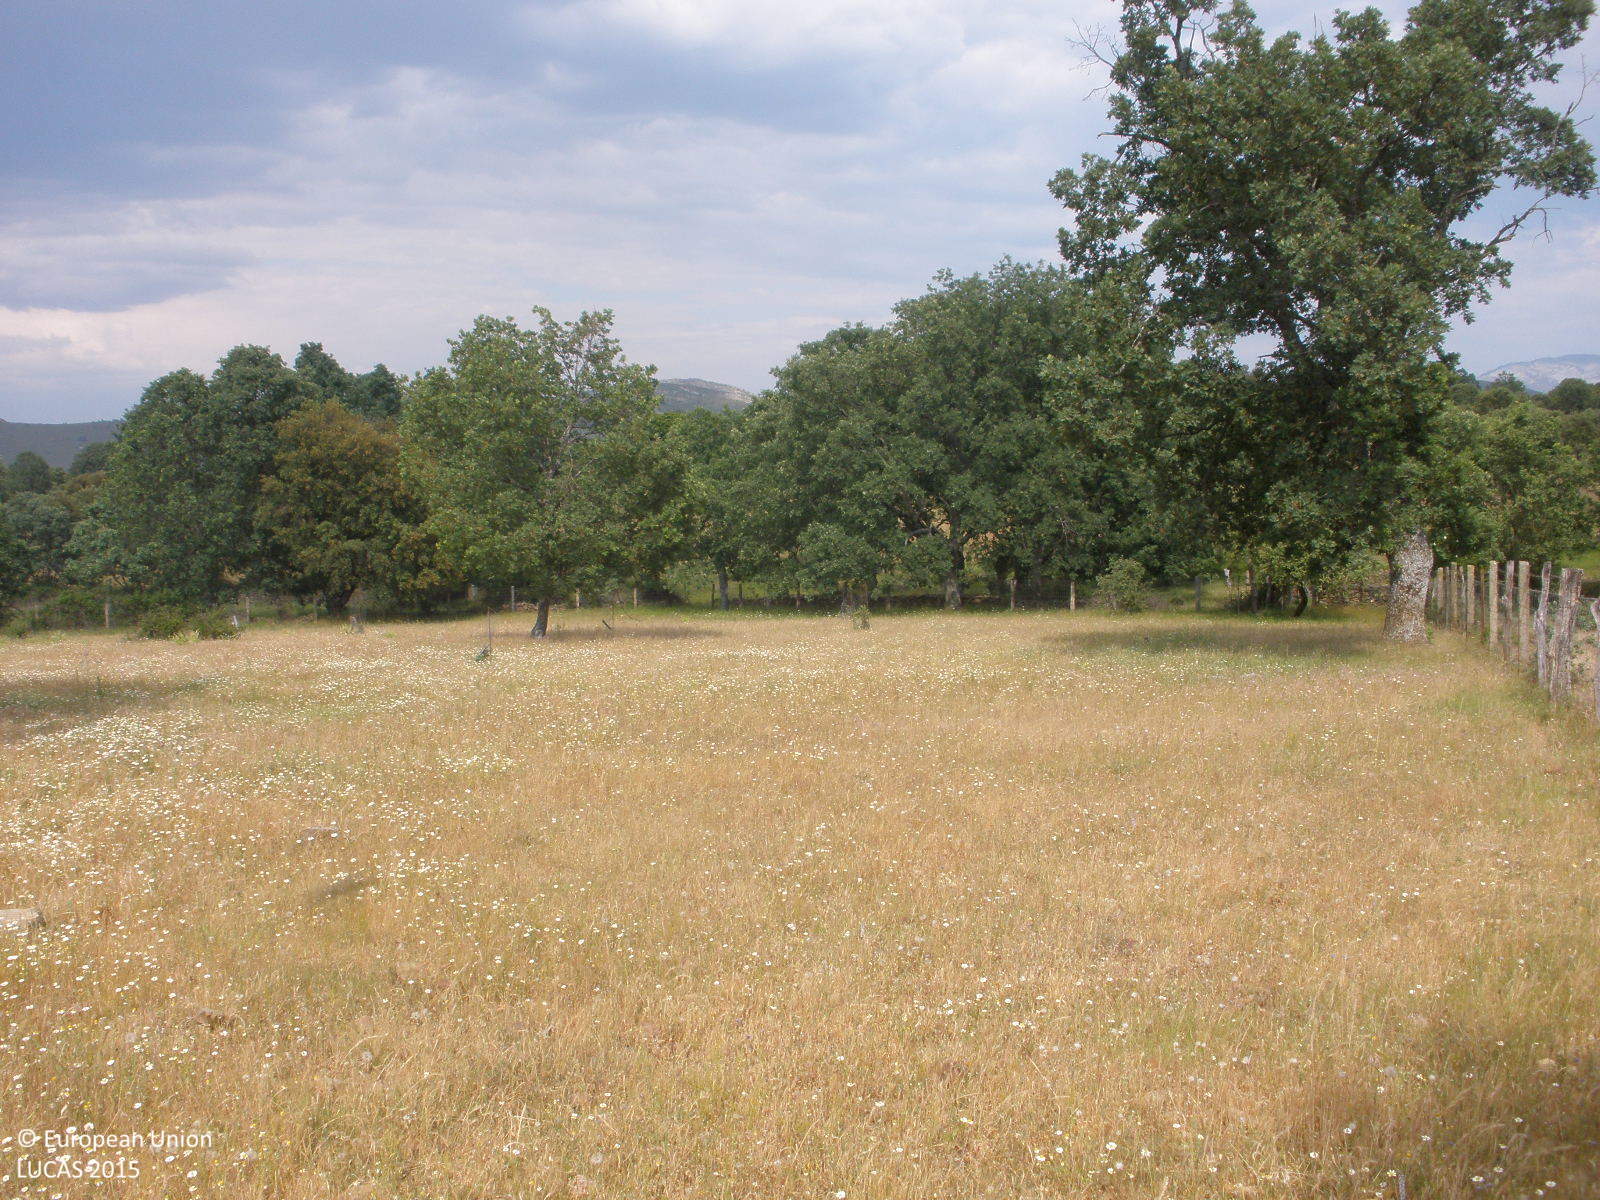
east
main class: Grassland
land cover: Grassland with sparse tree/shrub cover
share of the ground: > 75 %
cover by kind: herbaceous plants 80 %, unconsolidated bare surface 15 %, broadleaved forest trees 5 %
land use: Agriculture (excluding fallow land and kitchen gardens)
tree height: < 5 m
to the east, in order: Grassland with sparse tree/shrub cover; Fences; Grassland with sparse tree/shrub cover; Fences; Tracks; Dry stone walls; Broadleaved woodland; Grassland without tree/shrub cover; Fences; Grassland with sparse tree/shrub cover; Broadleaved woodland
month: June
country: ES
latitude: 40.5570
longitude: -6.3713
